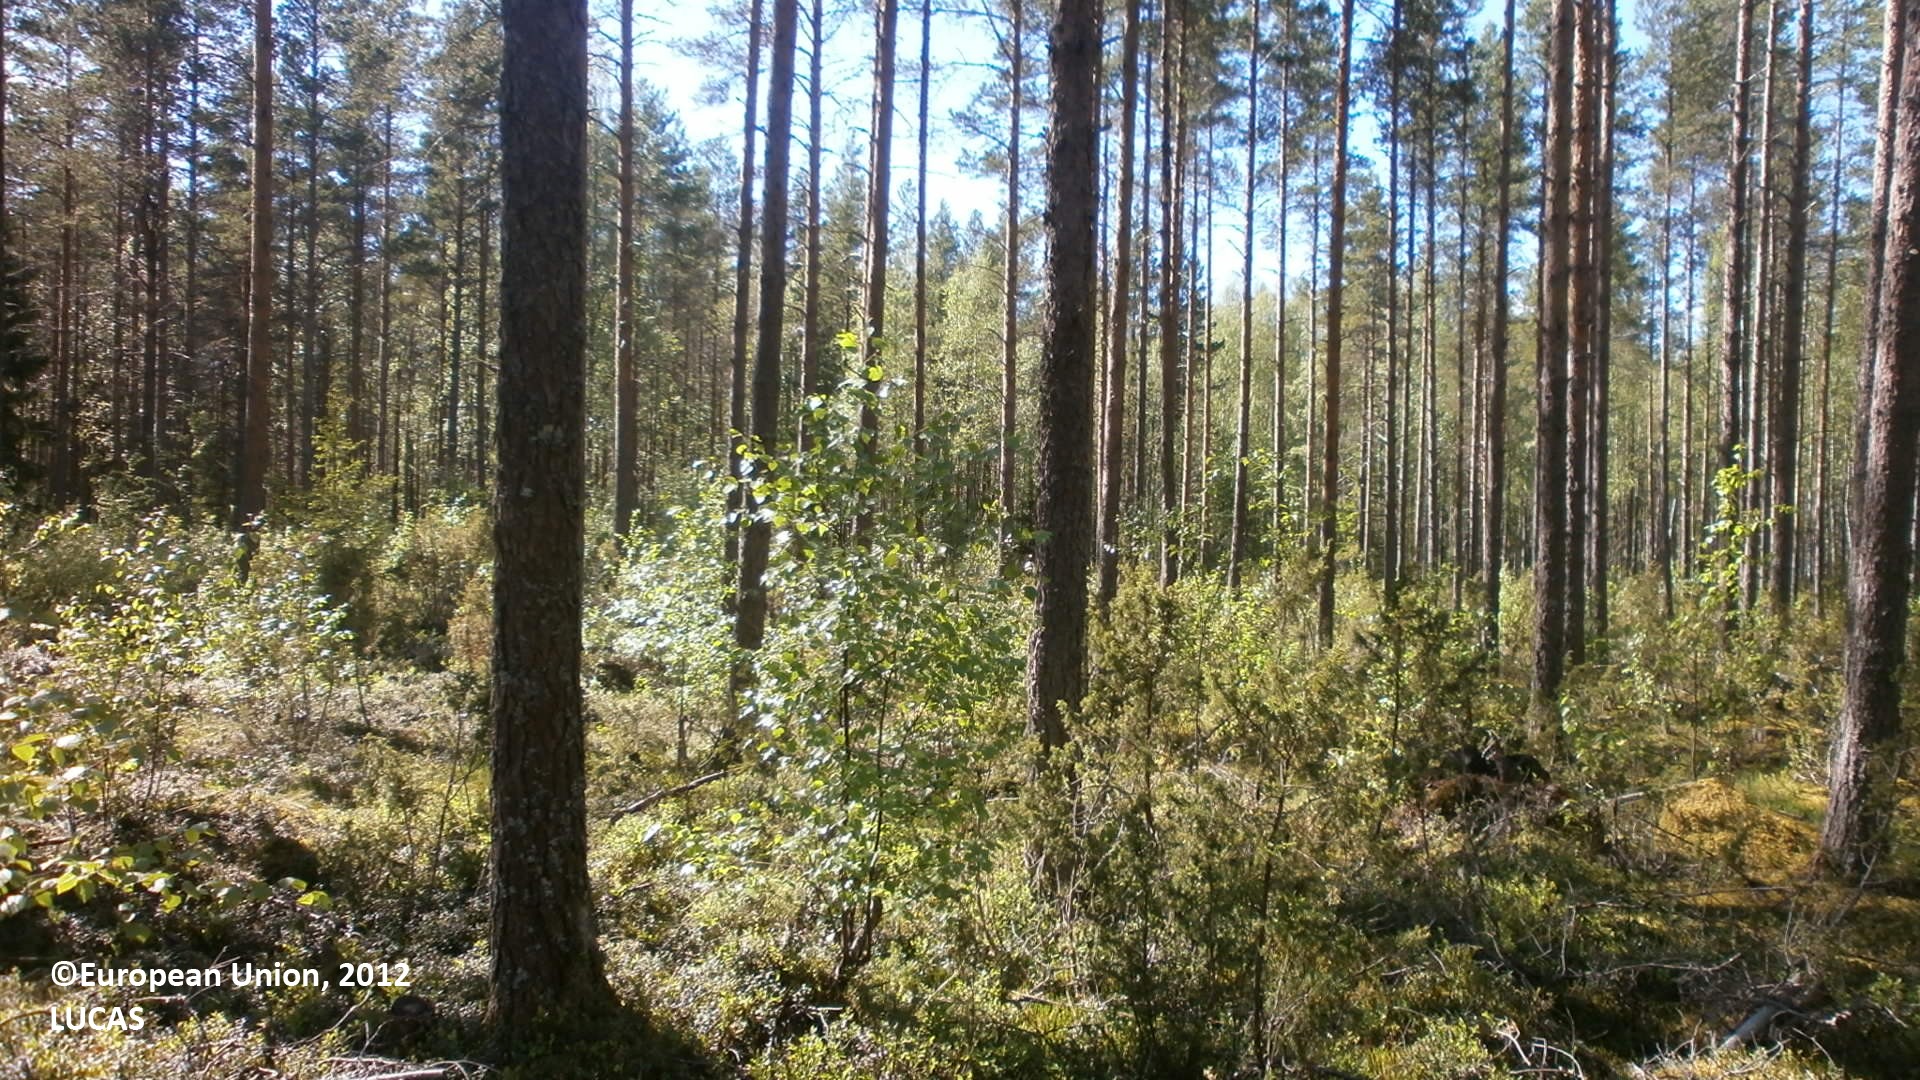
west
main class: Woodland
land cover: Pine dominated coniferous woodland
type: hemiboreal forest and nemoral coniferous forest and mixed broadleaved-coniferous forest
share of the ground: 25 - 50 %
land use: Forestry
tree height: > 5 m
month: June
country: FI
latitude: 64.1728
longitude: 25.7980
